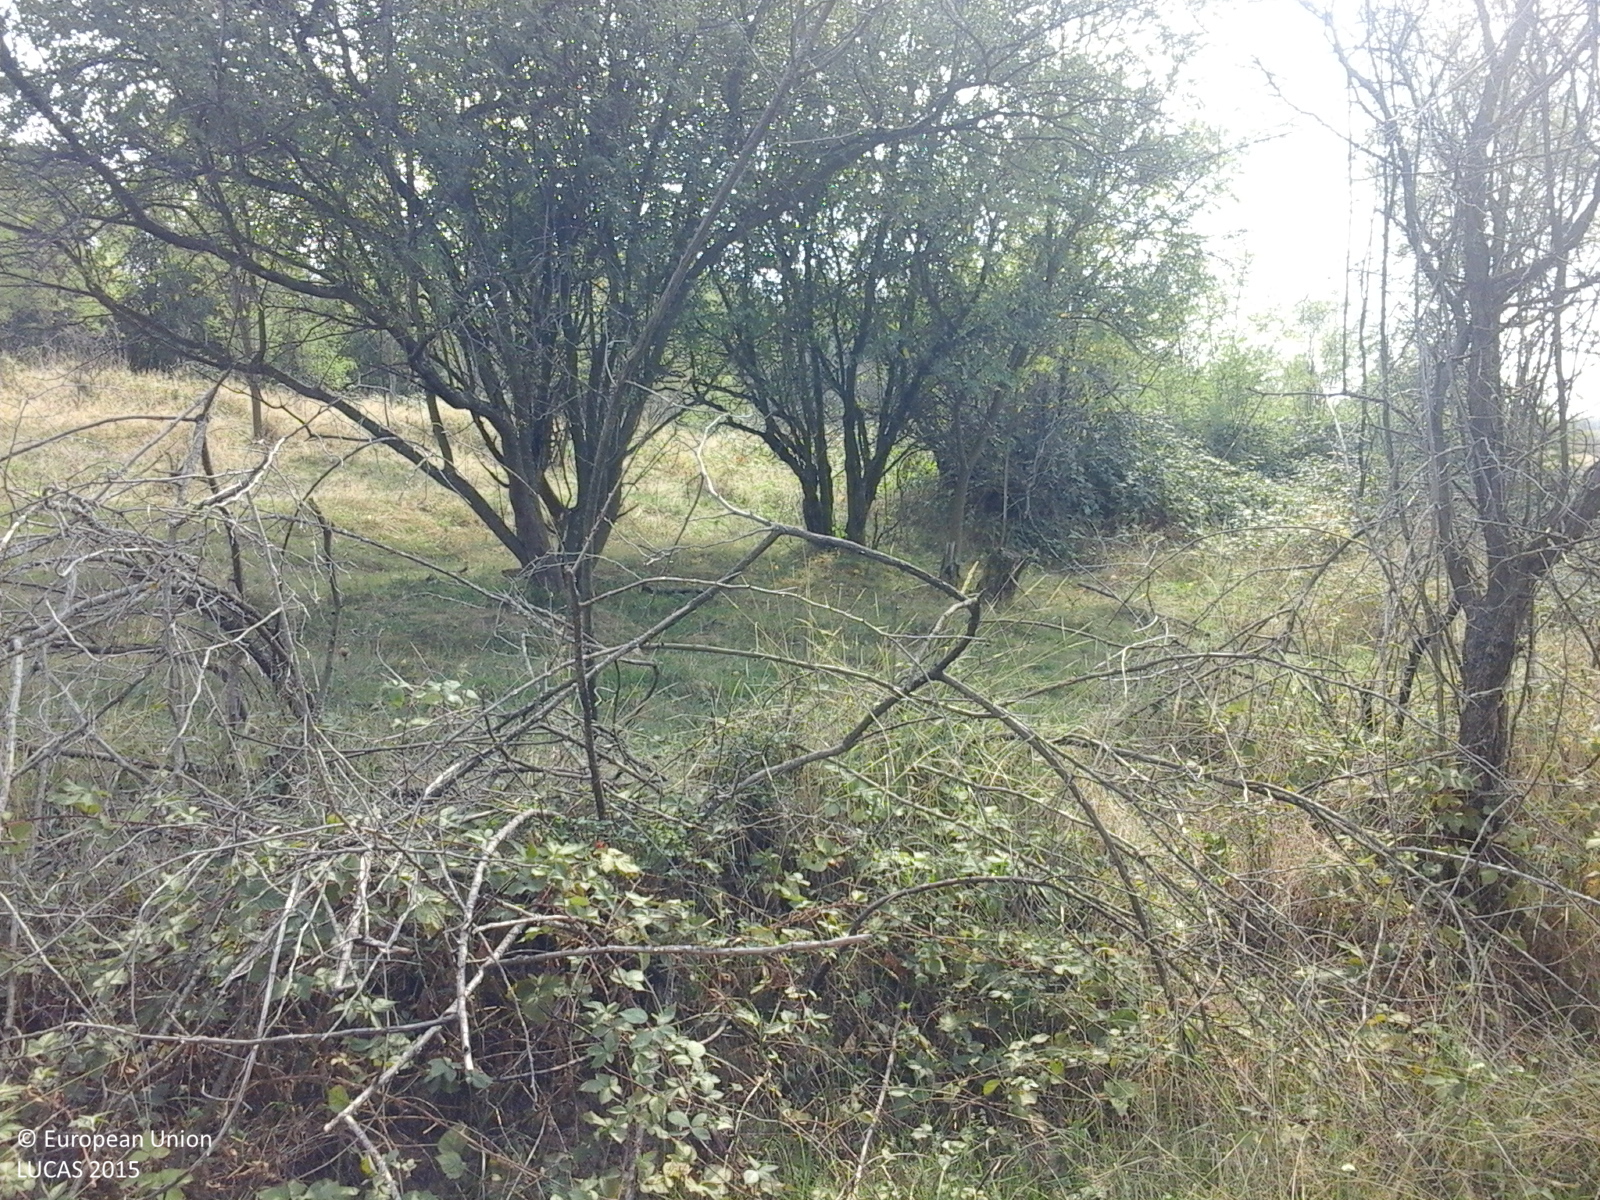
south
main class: Cropland
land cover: Cherry fruit
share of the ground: 25 - 50 %
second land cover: Grassland without tree/shrub cover
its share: > 75 %
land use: Agriculture (excluding fallow land and kitchen gardens)
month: September
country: RO
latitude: 45.5145
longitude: 22.1113
